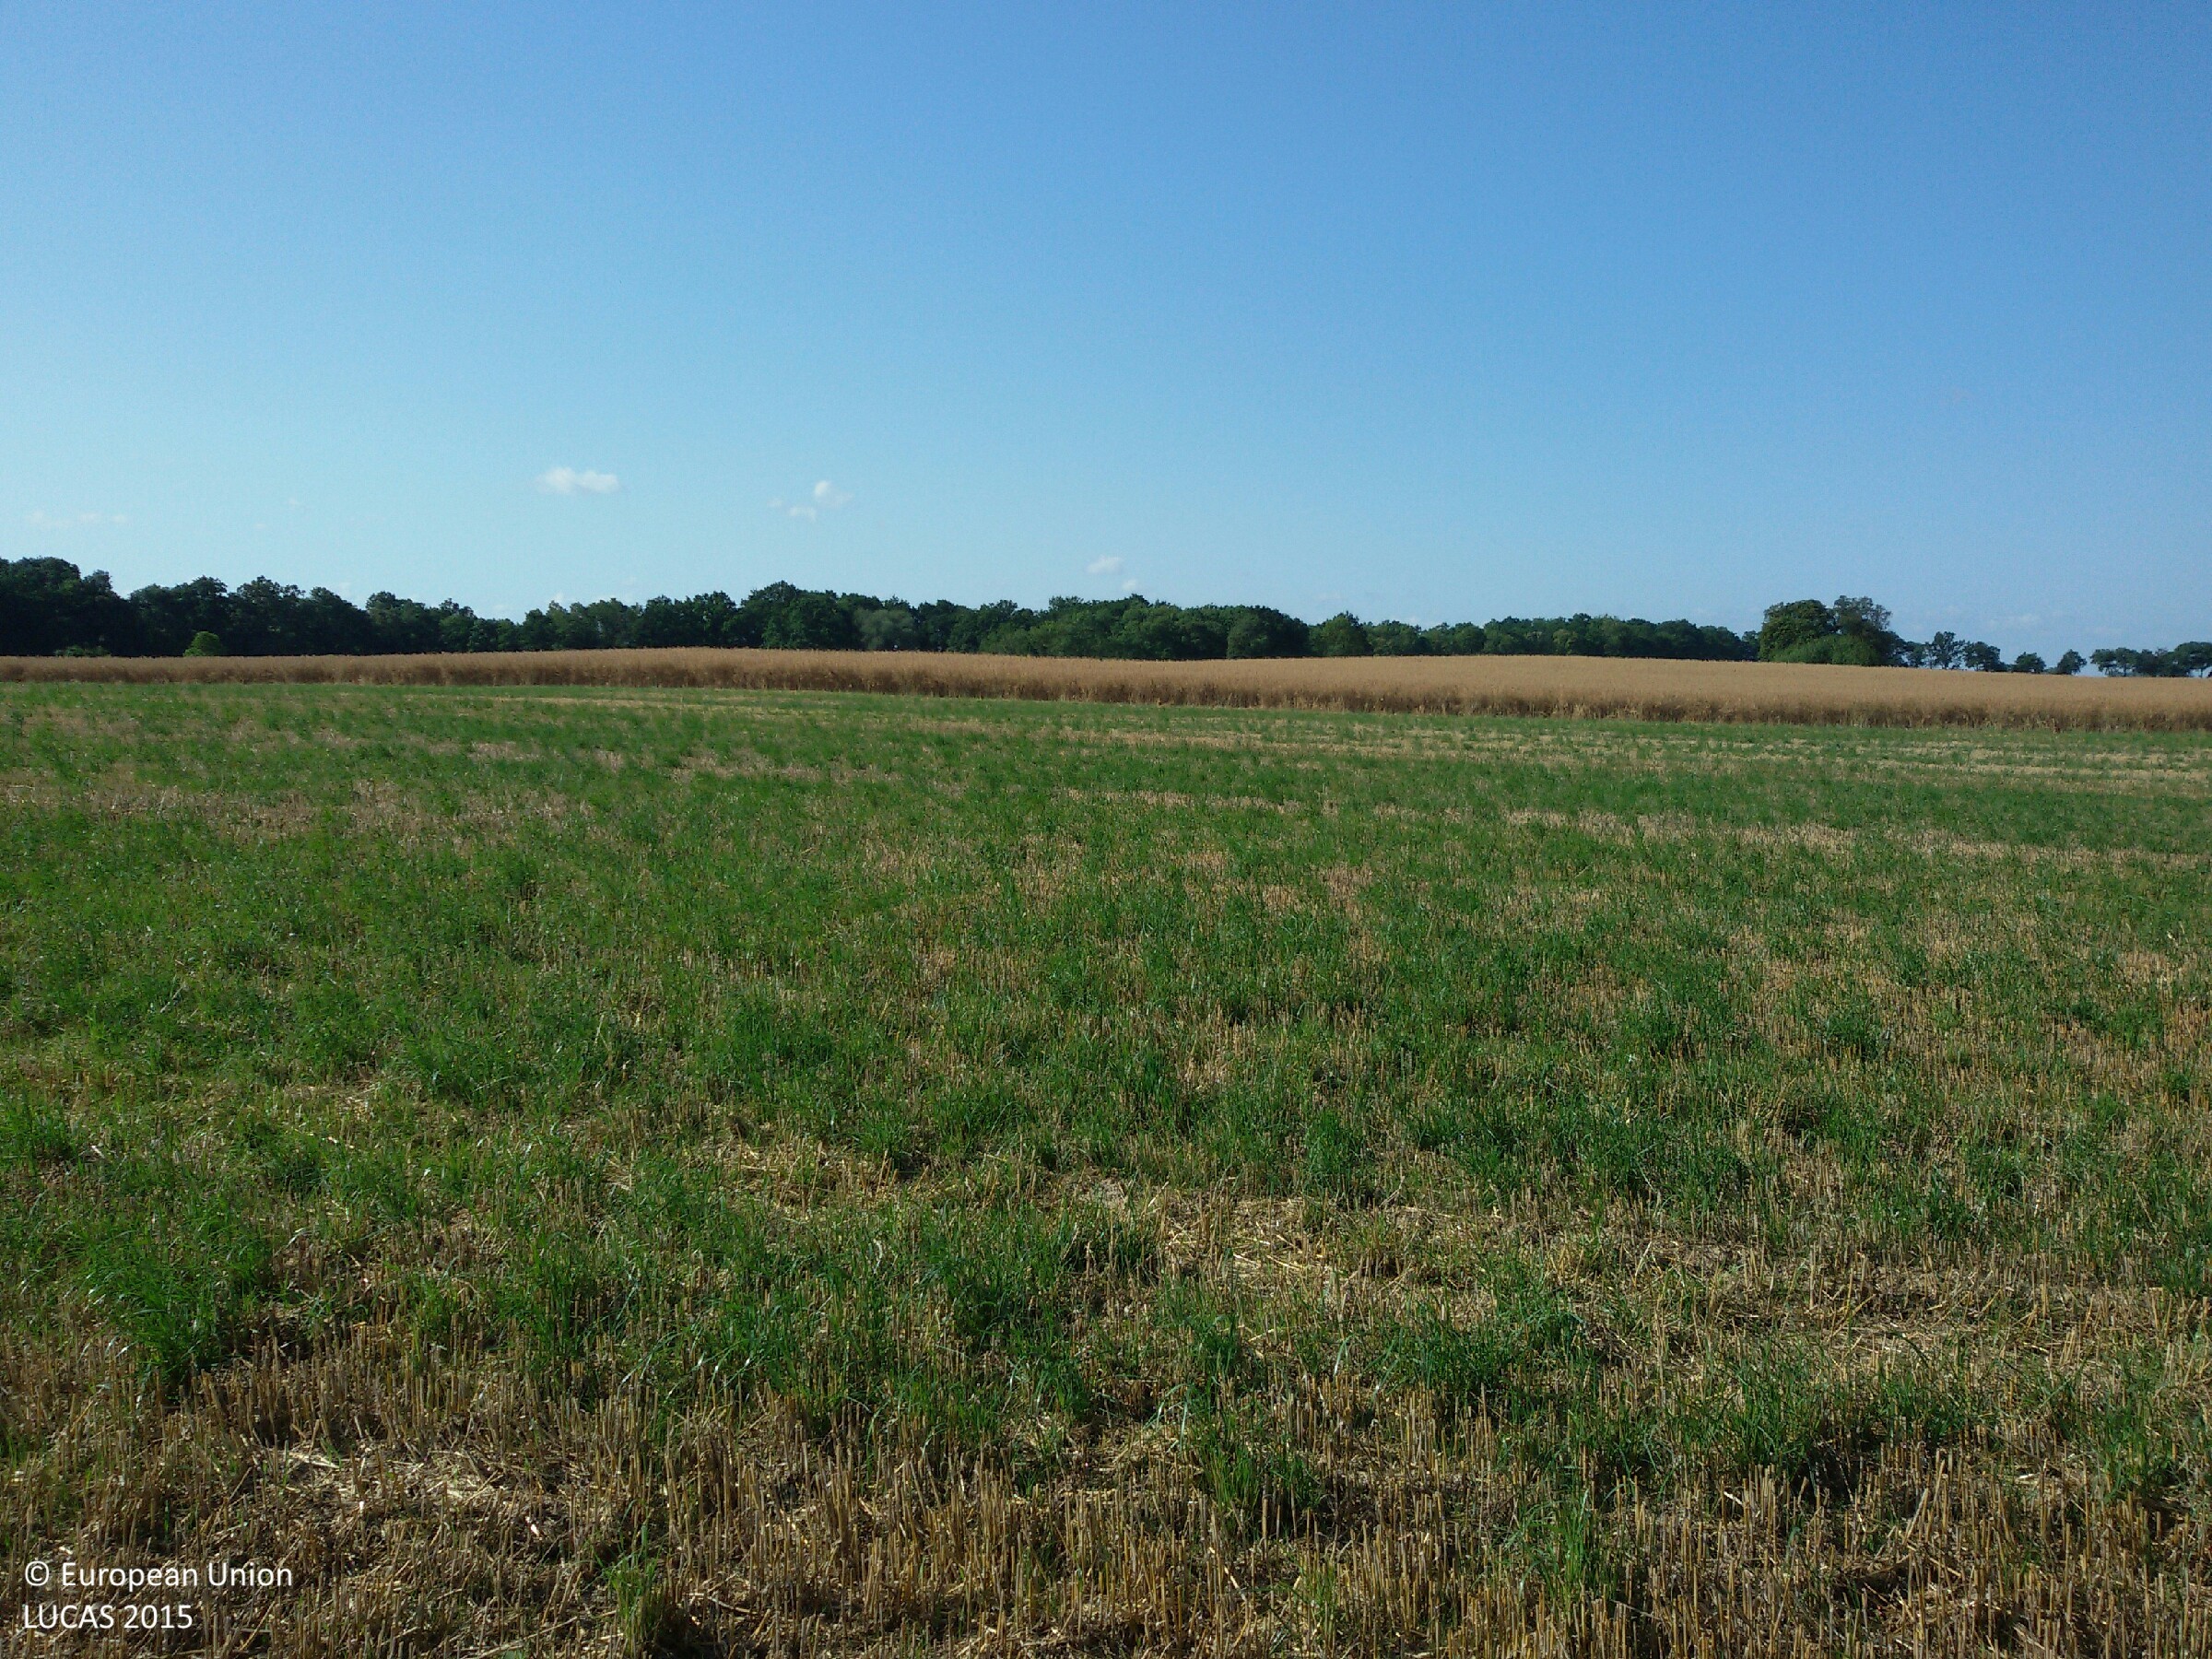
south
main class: Cropland
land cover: Common wheat
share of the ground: > 75 %
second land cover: Spontaneously vegetated surfaces
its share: 25 - 50 %
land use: Agriculture (excluding fallow land and kitchen gardens)
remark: Harvested field
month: July
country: PL
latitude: 52.7763
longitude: 14.5525
